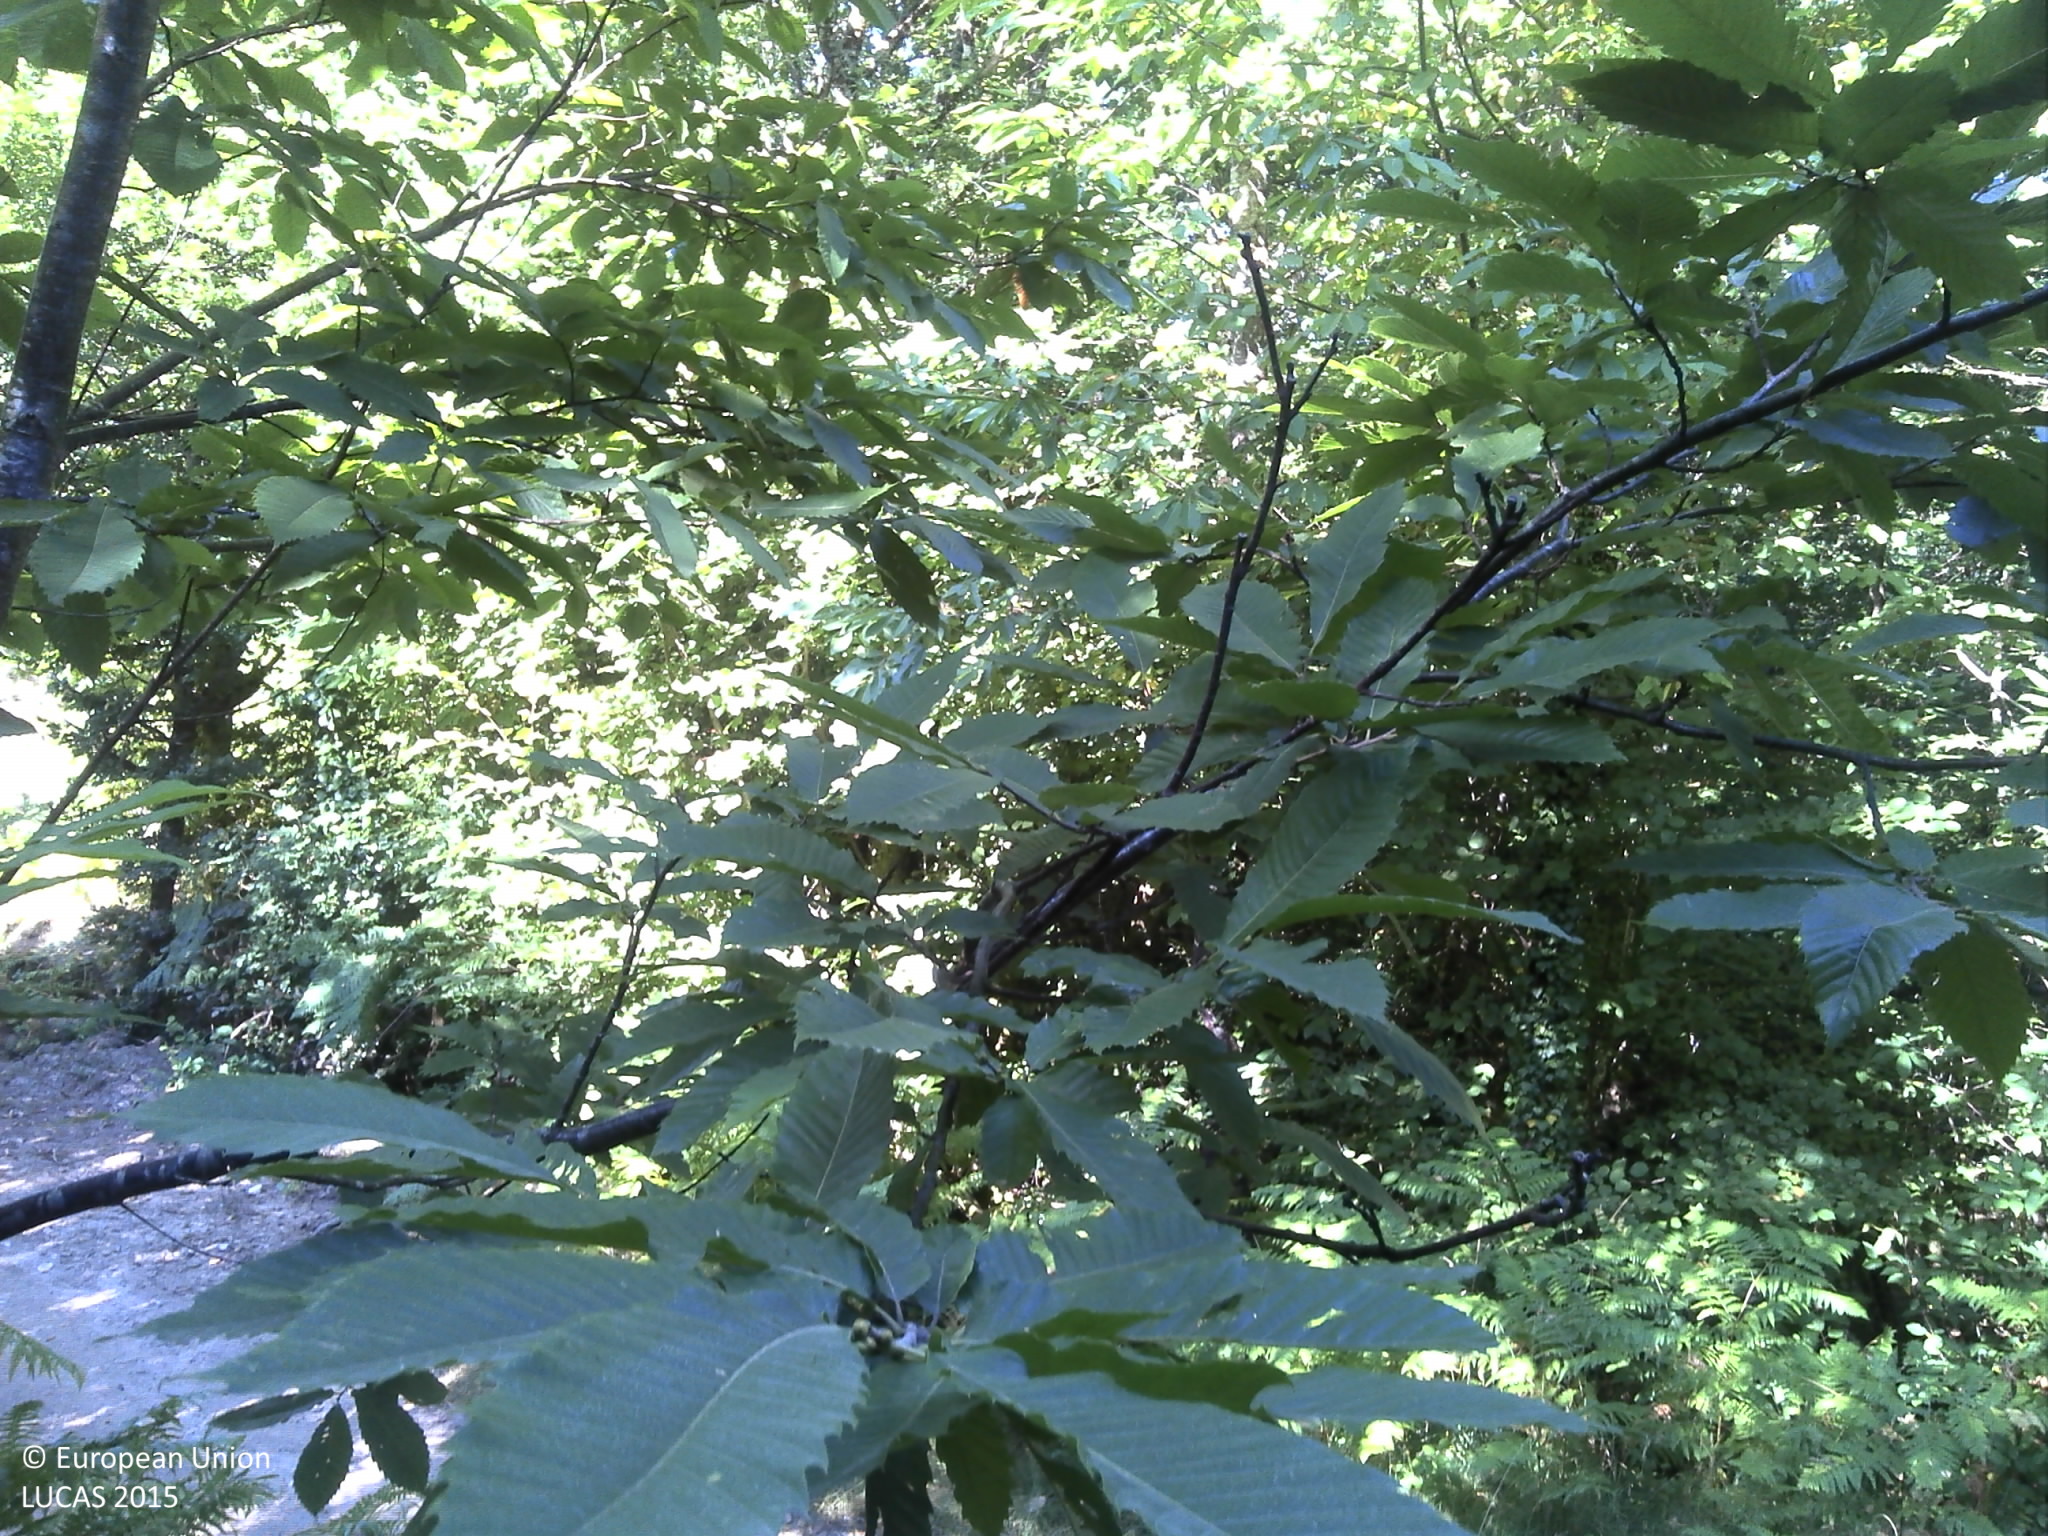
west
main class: Woodland
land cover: Broadleaved woodland
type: acidophilous oak and oak-birch forest
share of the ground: > 75 %
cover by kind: broadleaved forest trees 50 %, herbaceous plants 40 %, lichens and mosses 5 %, unconsolidated bare surface 5 %
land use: Forestry
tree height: > 5 m
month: July
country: FR
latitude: 45.0767
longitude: 1.8038
